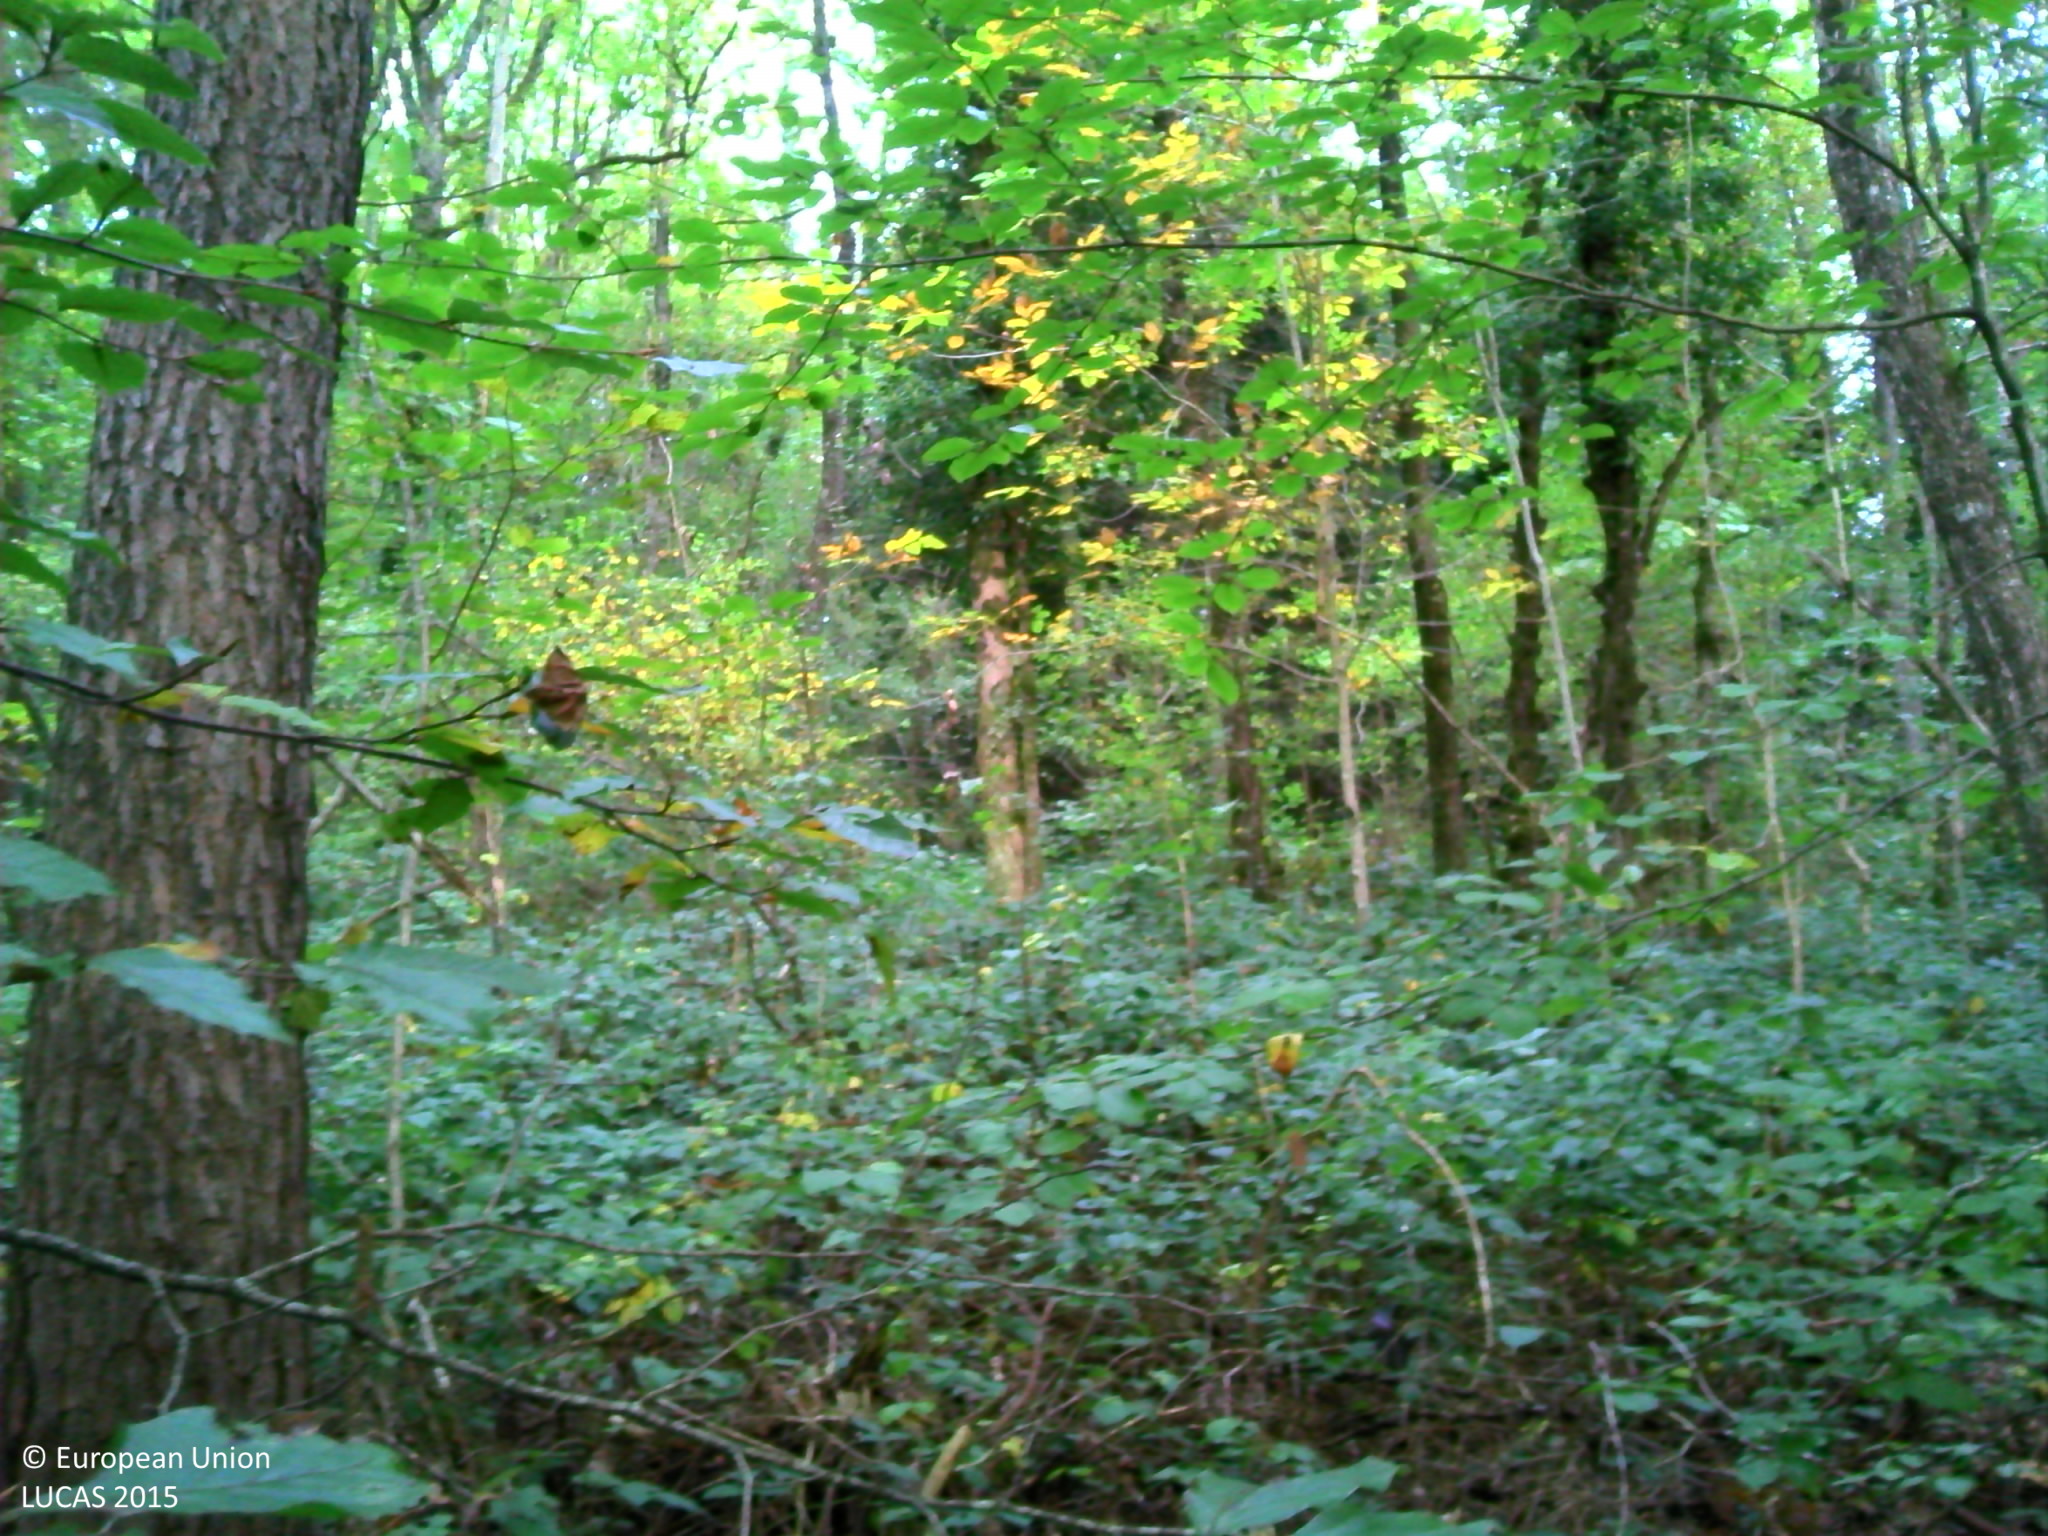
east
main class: Woodland
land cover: Broadleaved woodland
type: beech forest
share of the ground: > 75 %
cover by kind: broadleaved forest trees 90 %, shrubs 5 %, unconsolidated bare surface 5 %
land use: Forestry
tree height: > 5 m
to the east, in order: Broadleaved woodland; Tracks; Spruce dominated mixed woodland; Tracks; Spruce dominated mixed woodland; Rock outcrops; Broadleaved woodland
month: October
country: FR
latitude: 47.1080
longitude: 6.0618
